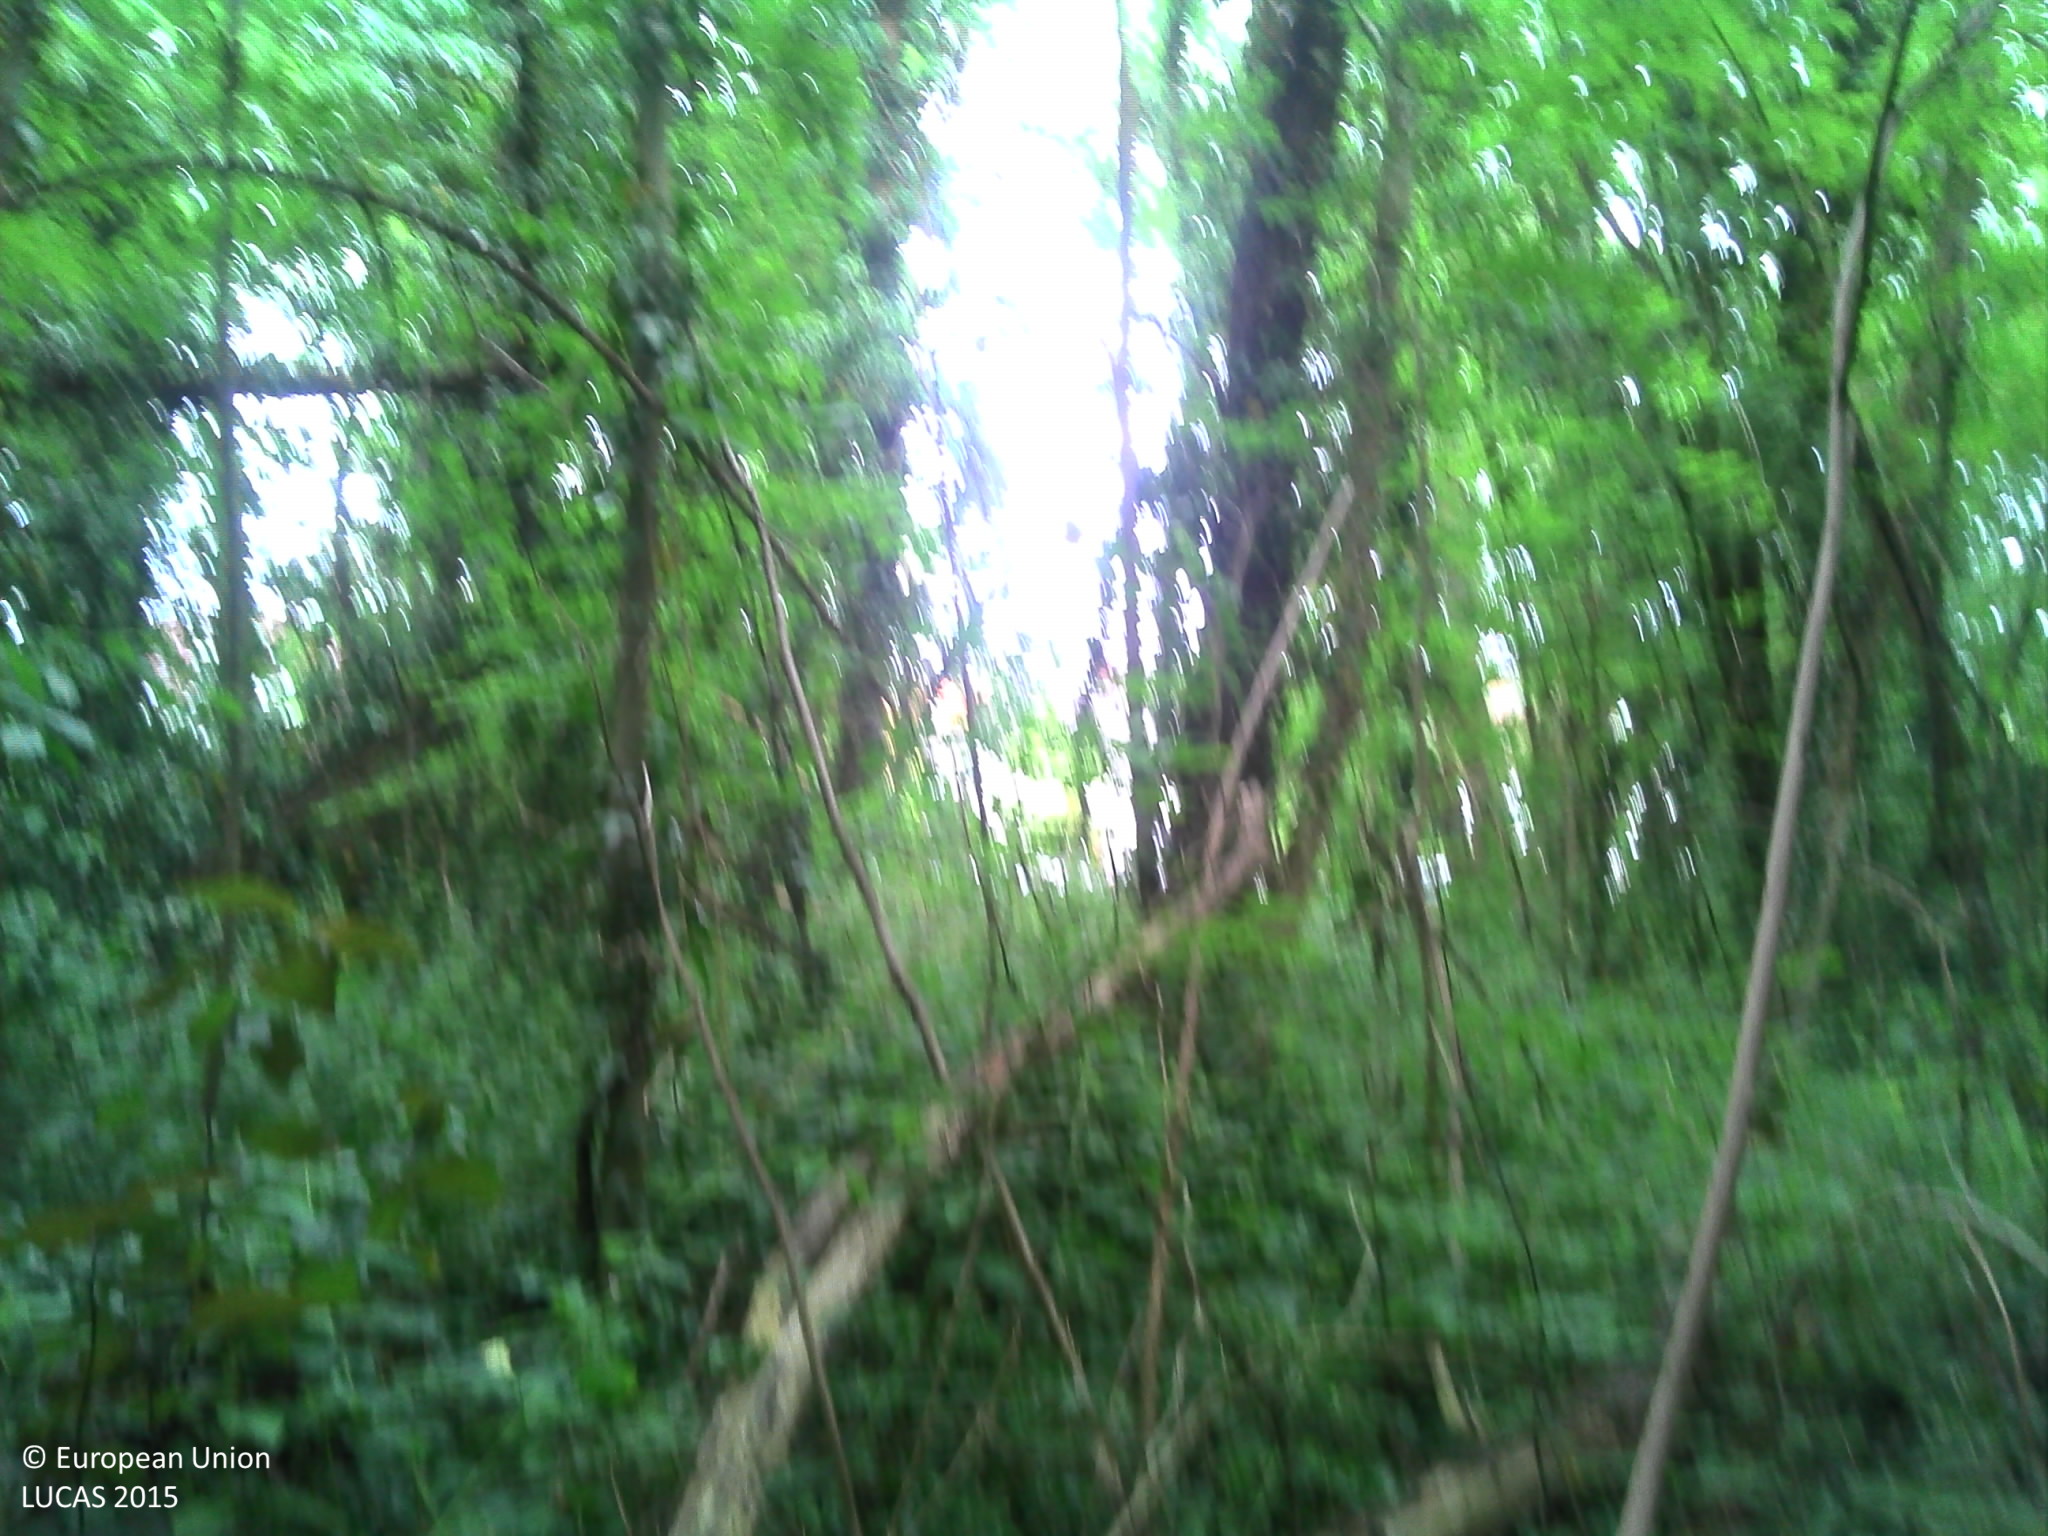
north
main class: Woodland
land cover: Broadleaved woodland
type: acidophilous oak and oak-birch forest
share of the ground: > 75 %
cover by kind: broadleaved forest trees 75 %, herbaceous plants 15 %, coniferous forest trees 10 %
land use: Forestry
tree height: > 5 m
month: June
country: BE
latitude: 50.8624
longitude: 4.4974
